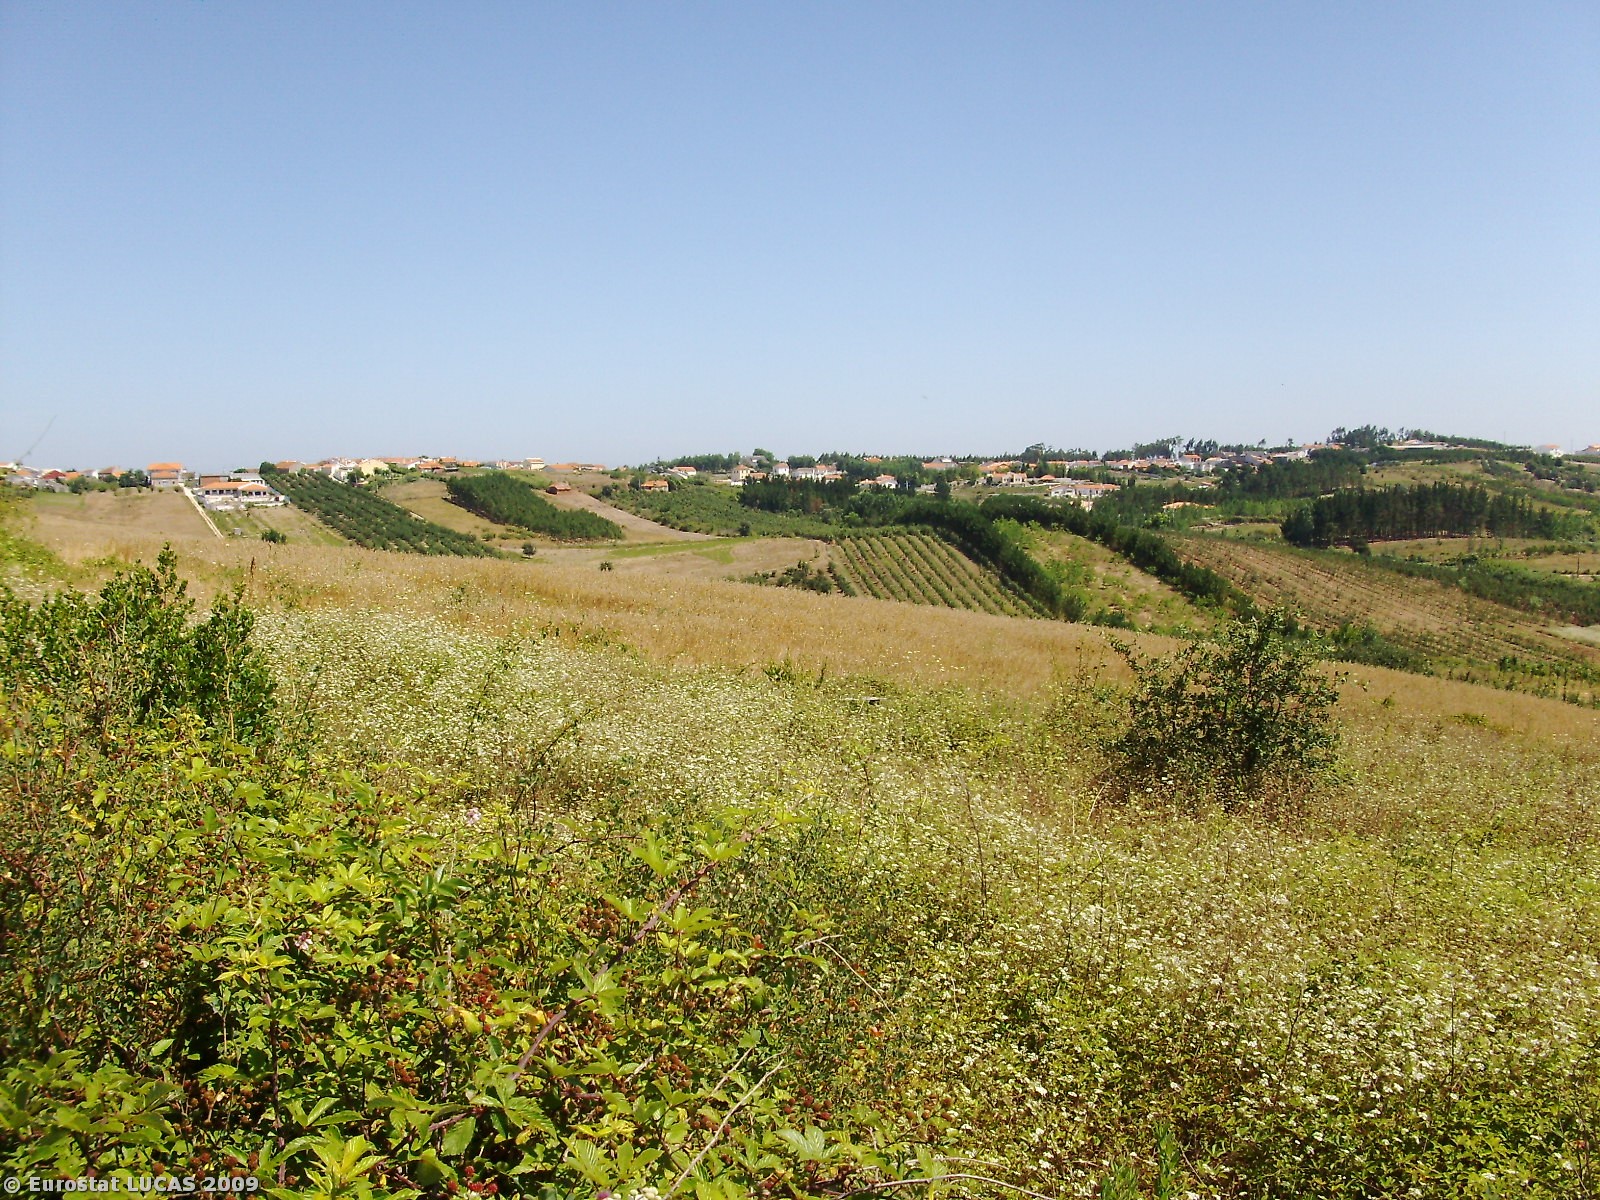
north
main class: Shrubland
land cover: Shrubland without tree cover
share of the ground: > 75 %
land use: Fallow land
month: July
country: PT
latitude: 39.6066
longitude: -8.9433
